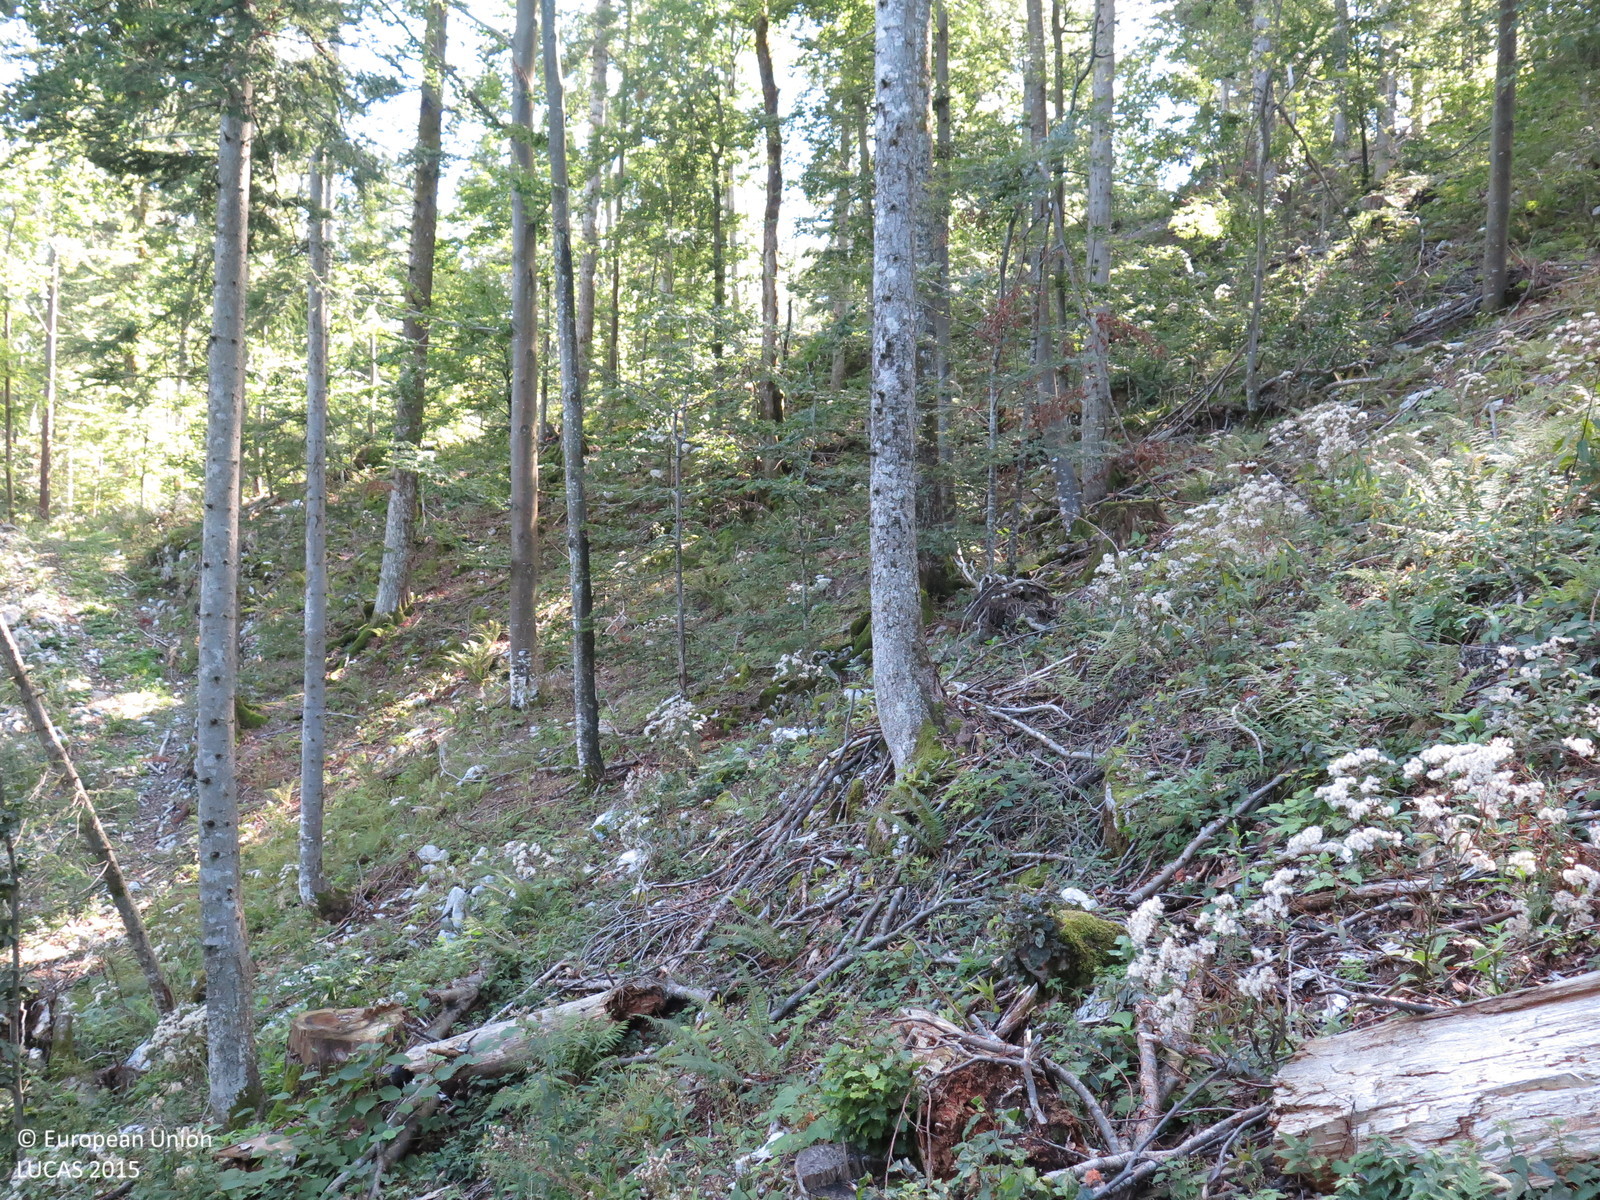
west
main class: Woodland
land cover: Other mixed woodland
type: mountainous beech forest
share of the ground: > 75 %
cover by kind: broadleaved forest trees 70 %, coniferous forest trees 25 %, unconsolidated bare surface 5 %
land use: Forestry
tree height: > 5 m
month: September
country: HR
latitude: 45.4736
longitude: 14.6643
